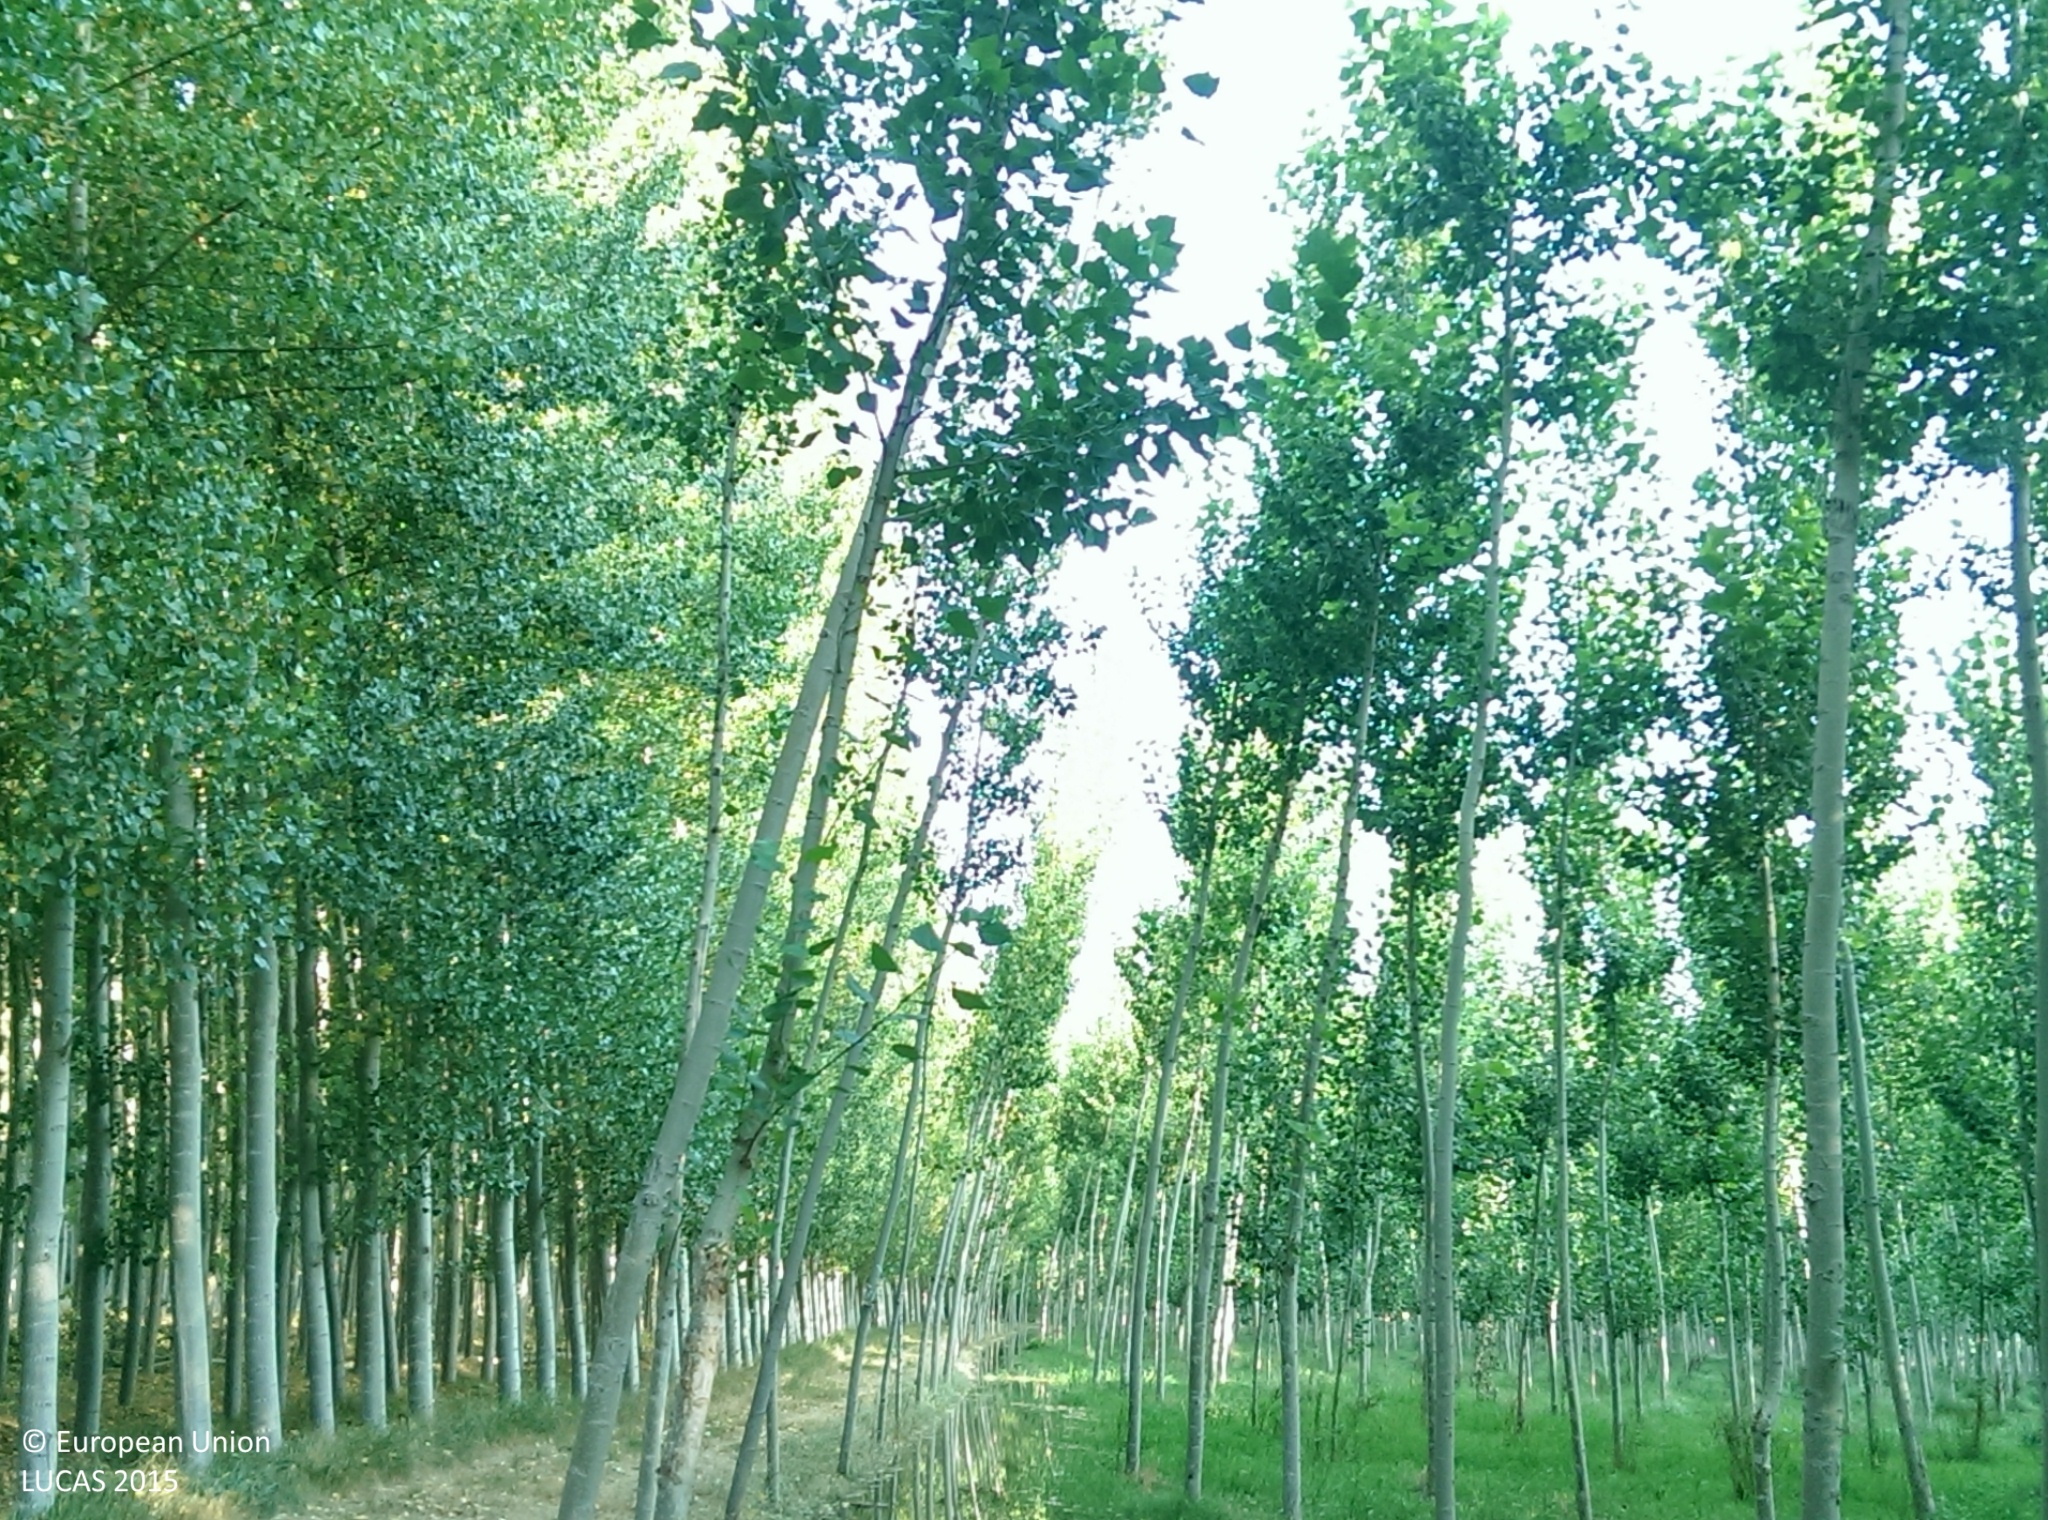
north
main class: Woodland
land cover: Broadleaved woodland
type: exotic forest
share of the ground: > 75 %
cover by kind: broadleaved forest trees 80 %, herbaceous plants 10 %, unconsolidated bare surface 10 %
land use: Forestry
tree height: > 5 m
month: July
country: ES
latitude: 37.3959
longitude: -3.1711
